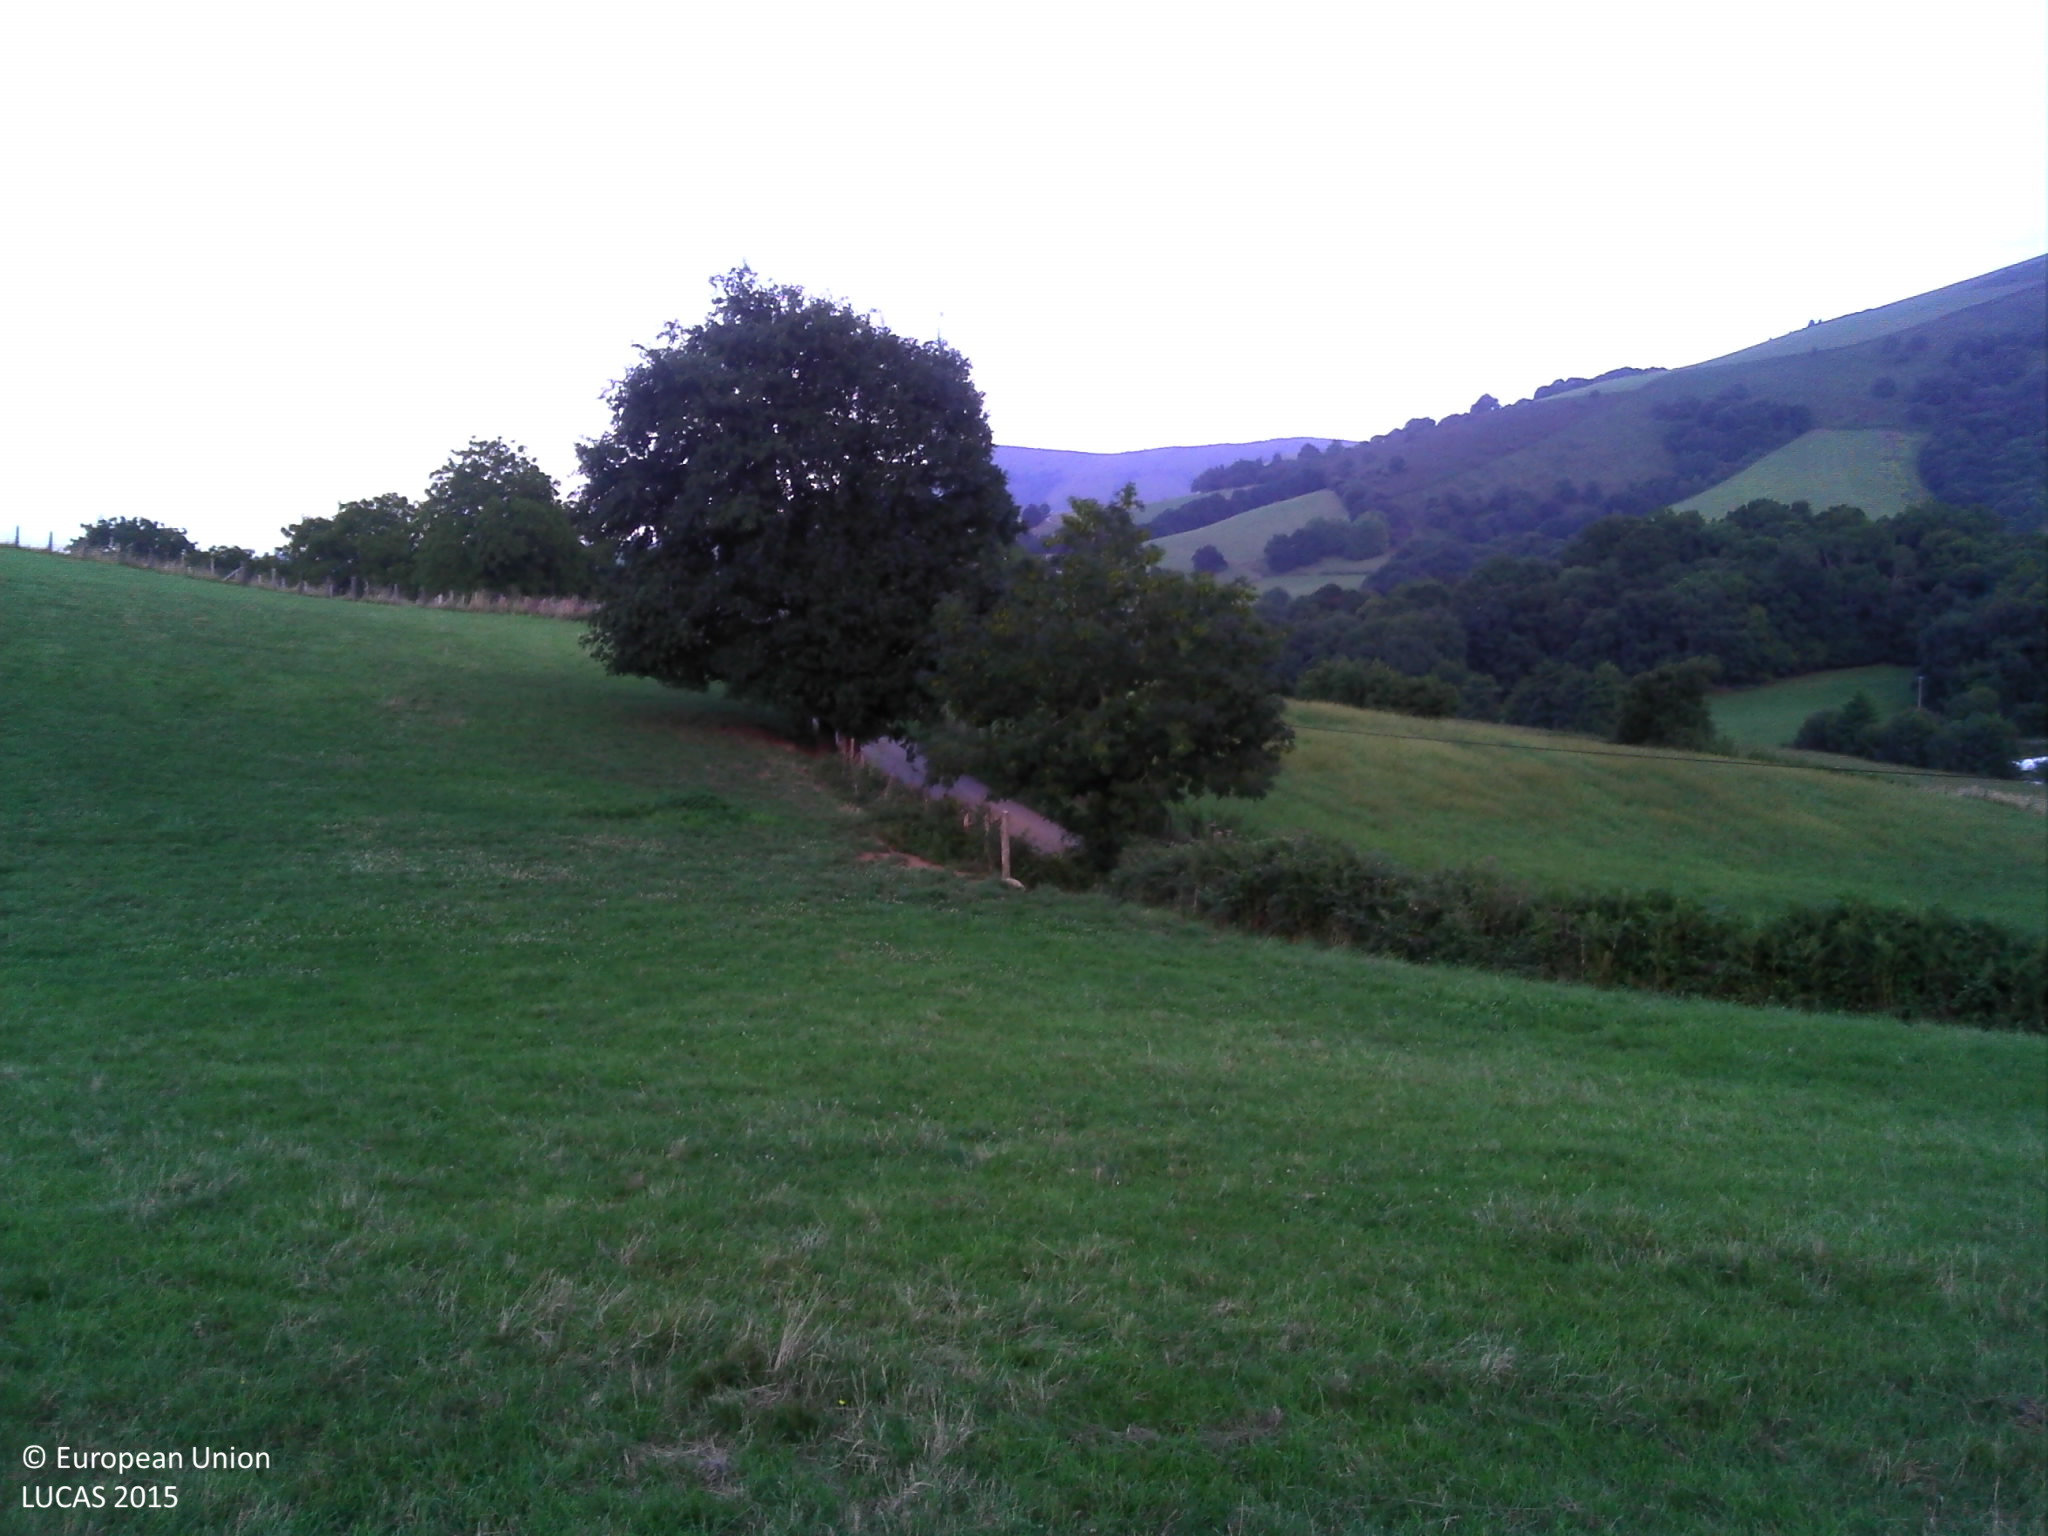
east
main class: Grassland
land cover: Grassland without tree/shrub cover
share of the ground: > 75 %
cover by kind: herbaceous plants 100 %
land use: Agriculture (excluding fallow land and kitchen gardens)
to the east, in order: Grassland without tree/shrub cover; Fences; Managed hedges; Ditches and canals; Paved roads, cycling and walking lanes; Grass margins; Fences; Grassland without tree/shrub cover; Shrubland with sparse tree cover; Fences; Grassland without tree/shrub cover; Fences; Grassland without tree/shrub cover; Artificial constructions in urban areas; Grassland without tree/shrub cover
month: August
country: FR
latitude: 43.2703
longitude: -1.1888
